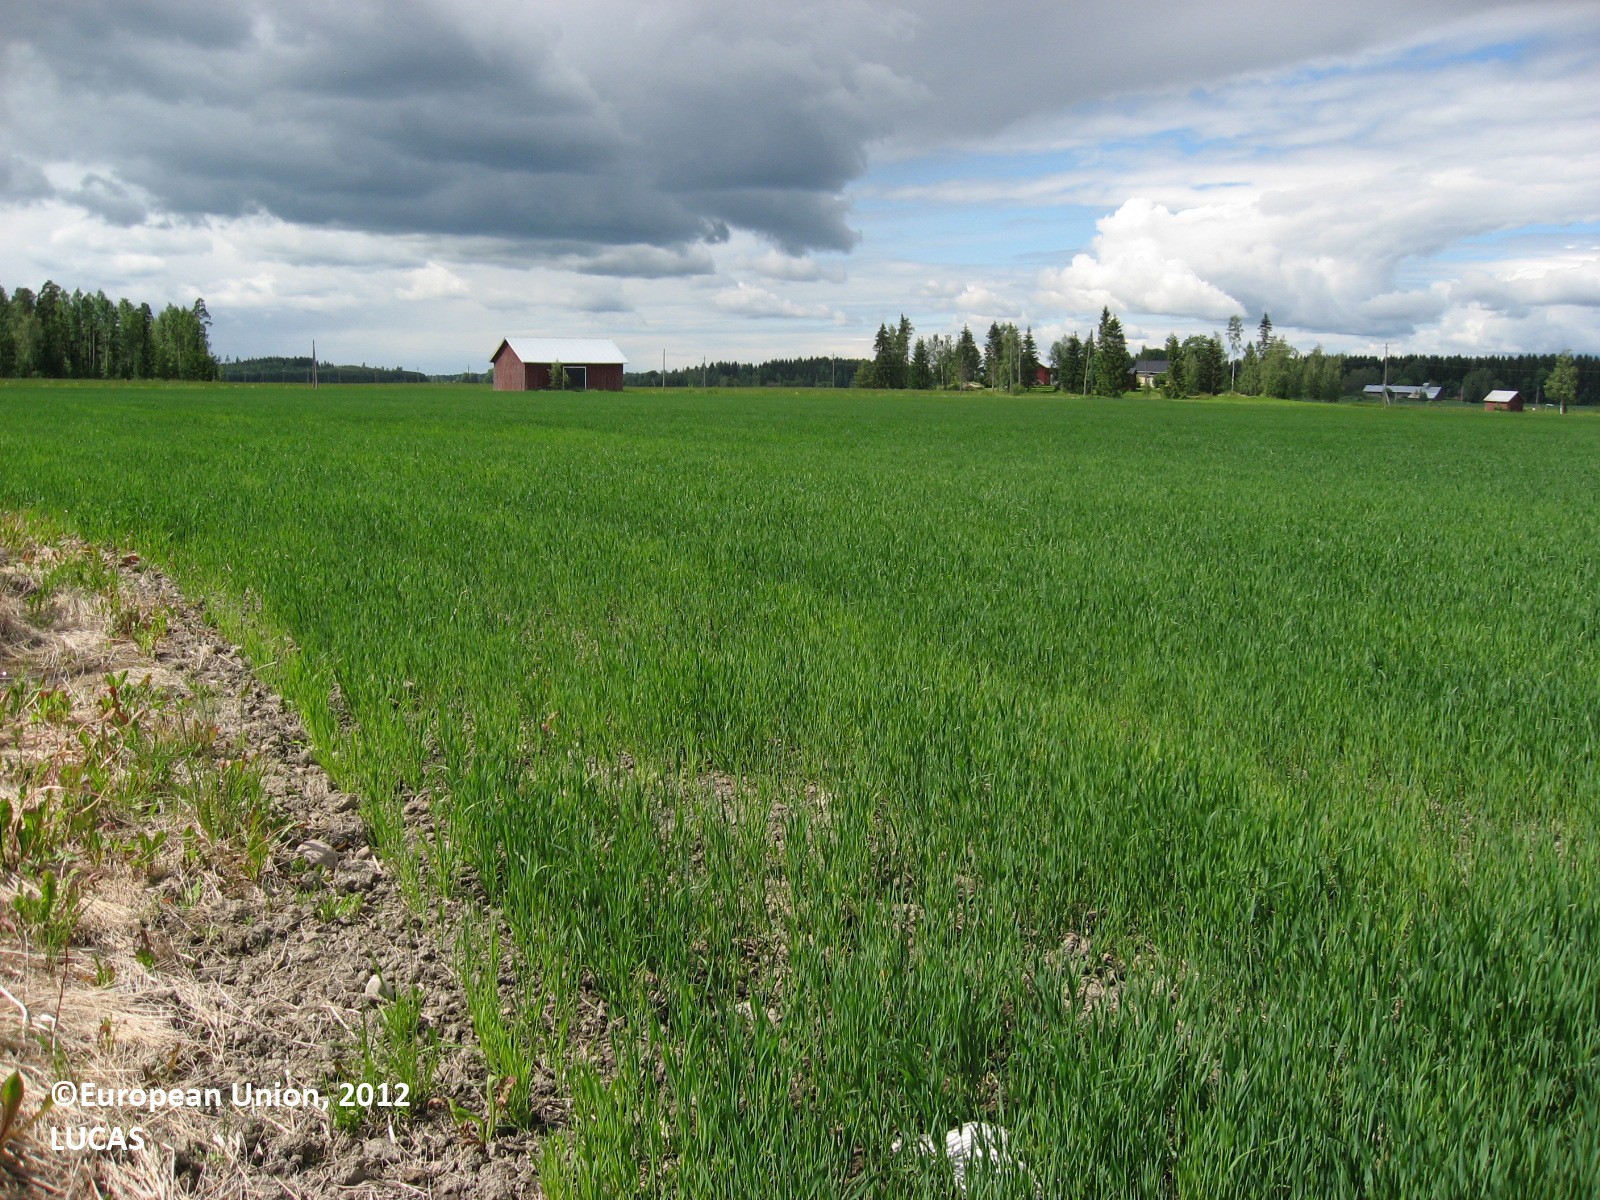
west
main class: Cropland
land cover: Oats
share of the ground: 50 - 75 %
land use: Agriculture (excluding fallow land and kitchen gardens)
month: June
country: FI
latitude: 60.7275
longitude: 26.5273
